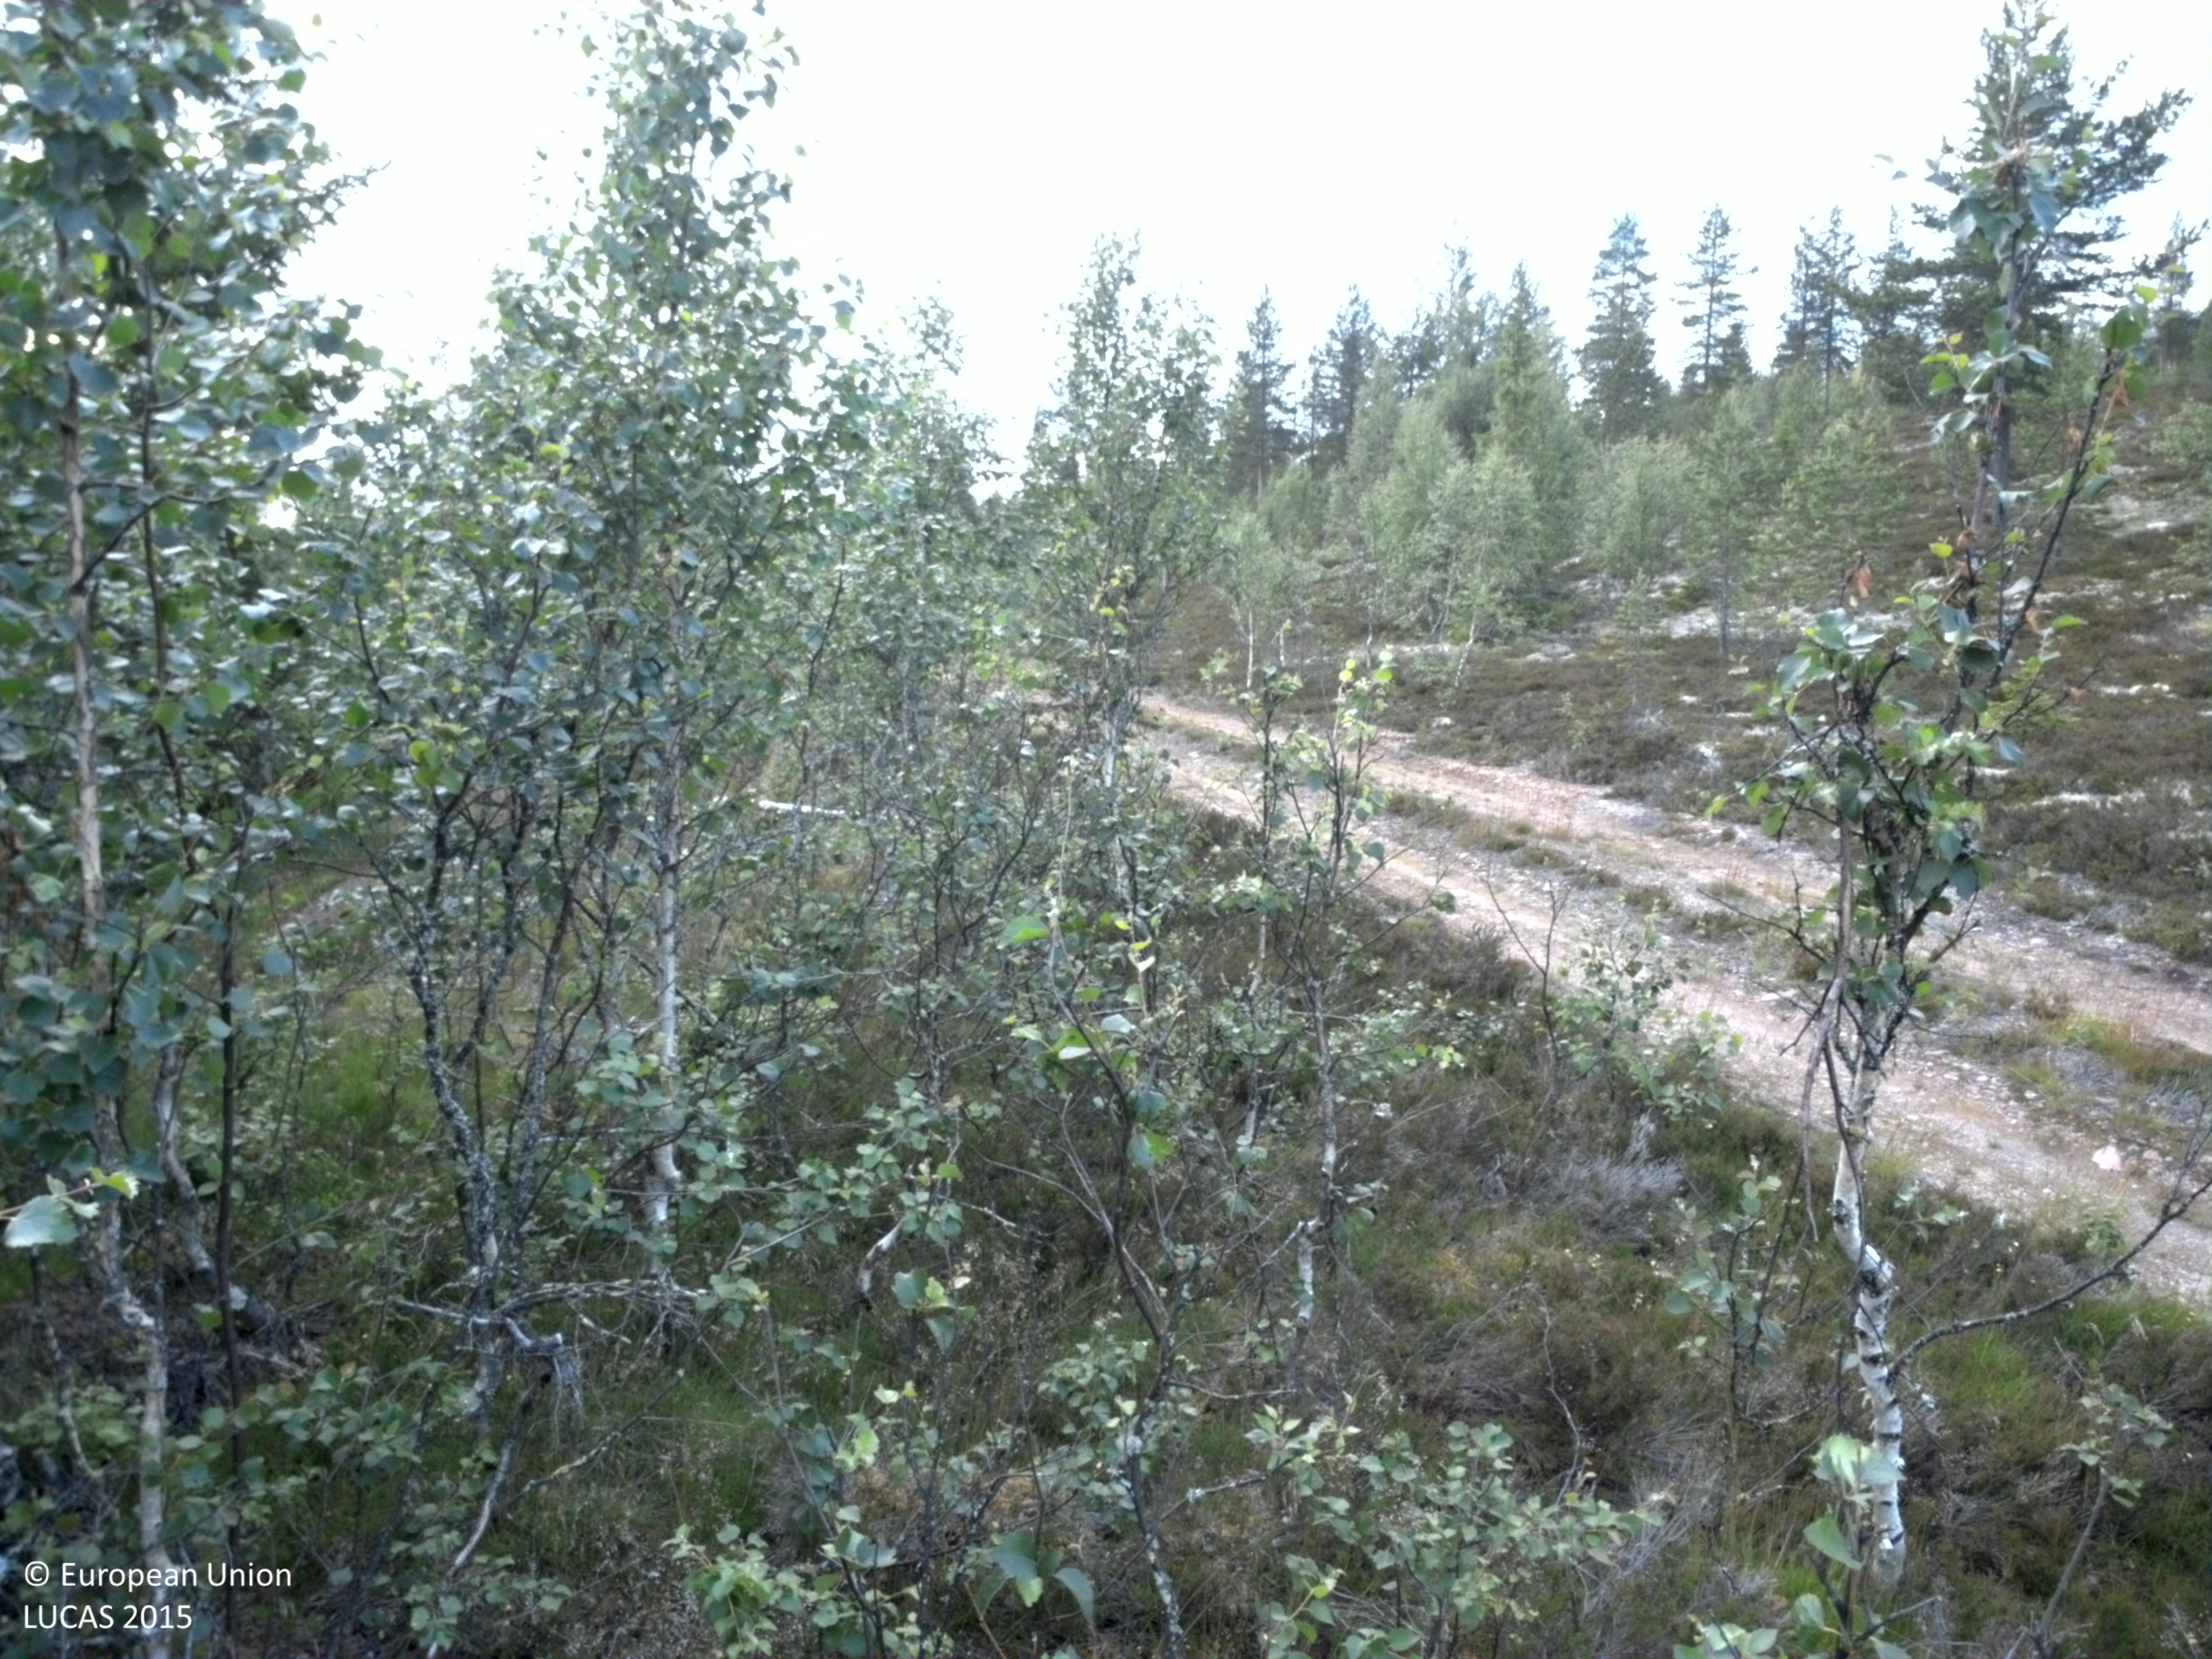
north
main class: Woodland
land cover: Broadleaved woodland
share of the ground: 50 - 75 %
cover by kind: broadleaved forest trees 70 %, shrubs 20 %, lichens and mosses 10 %
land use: Forestry
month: July
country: SE
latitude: 61.6115
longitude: 13.6631
